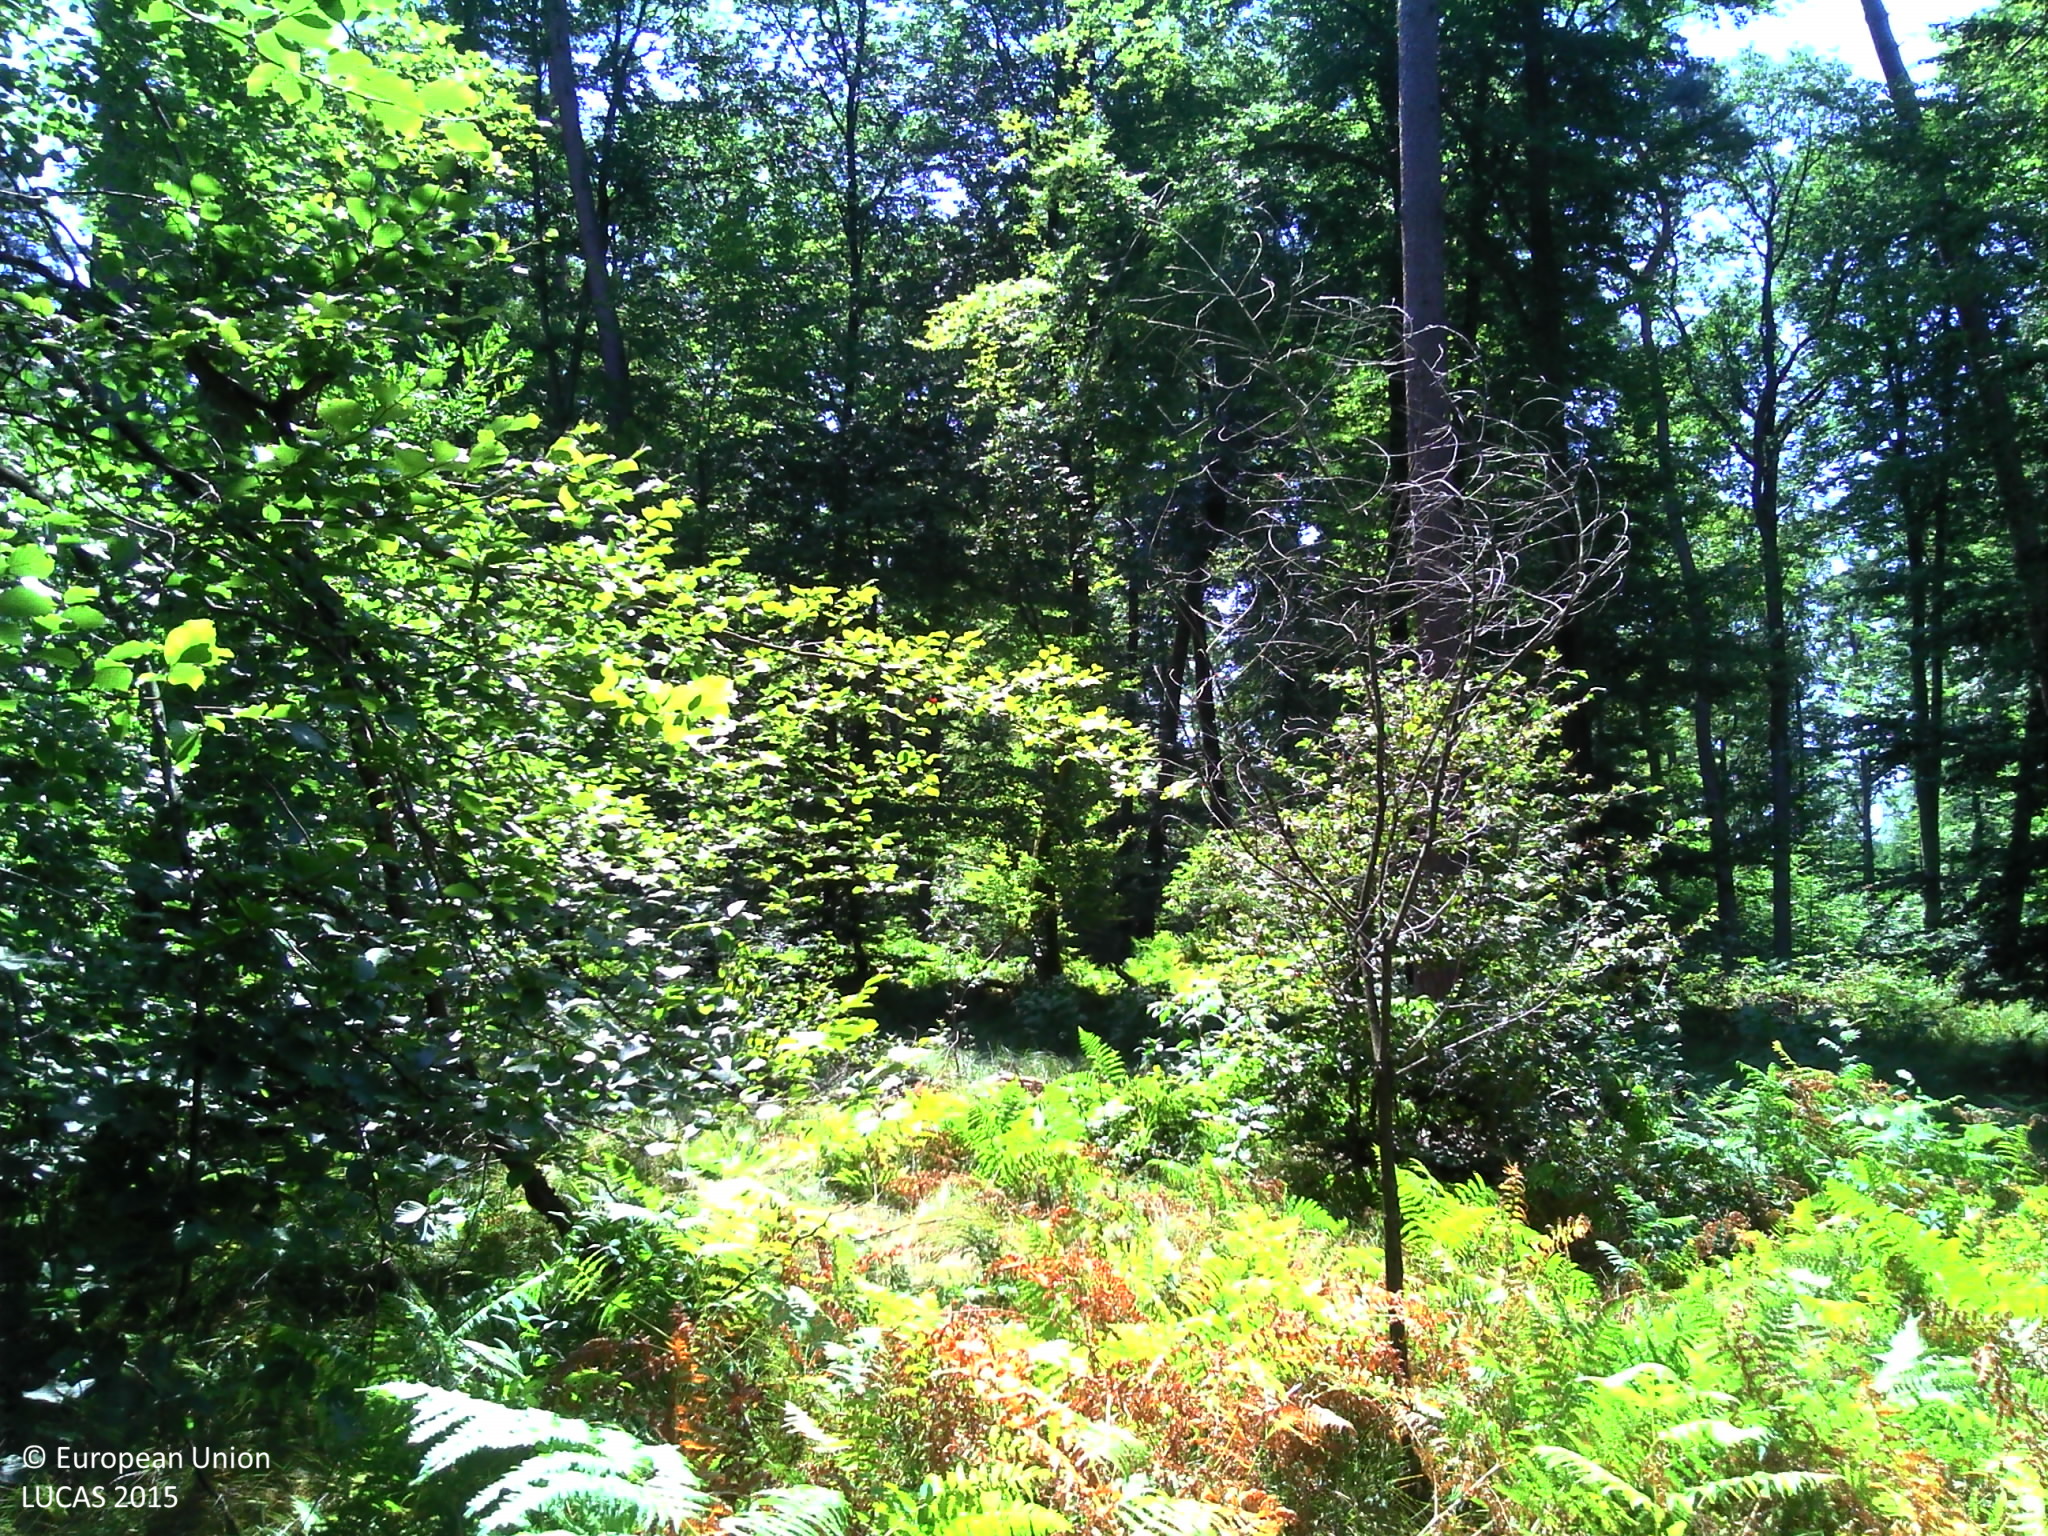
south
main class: Woodland
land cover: Pine dominated mixed woodland
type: hemiboreal forest and nemoral coniferous forest and mixed broadleaved-coniferous forest
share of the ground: > 75 %
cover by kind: broadleaved forest trees 50 %, coniferous forest trees 35 %, herbaceous plants 15 %
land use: Forestry
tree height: > 5 m
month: August
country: FR
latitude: 48.8897
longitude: 8.0231
